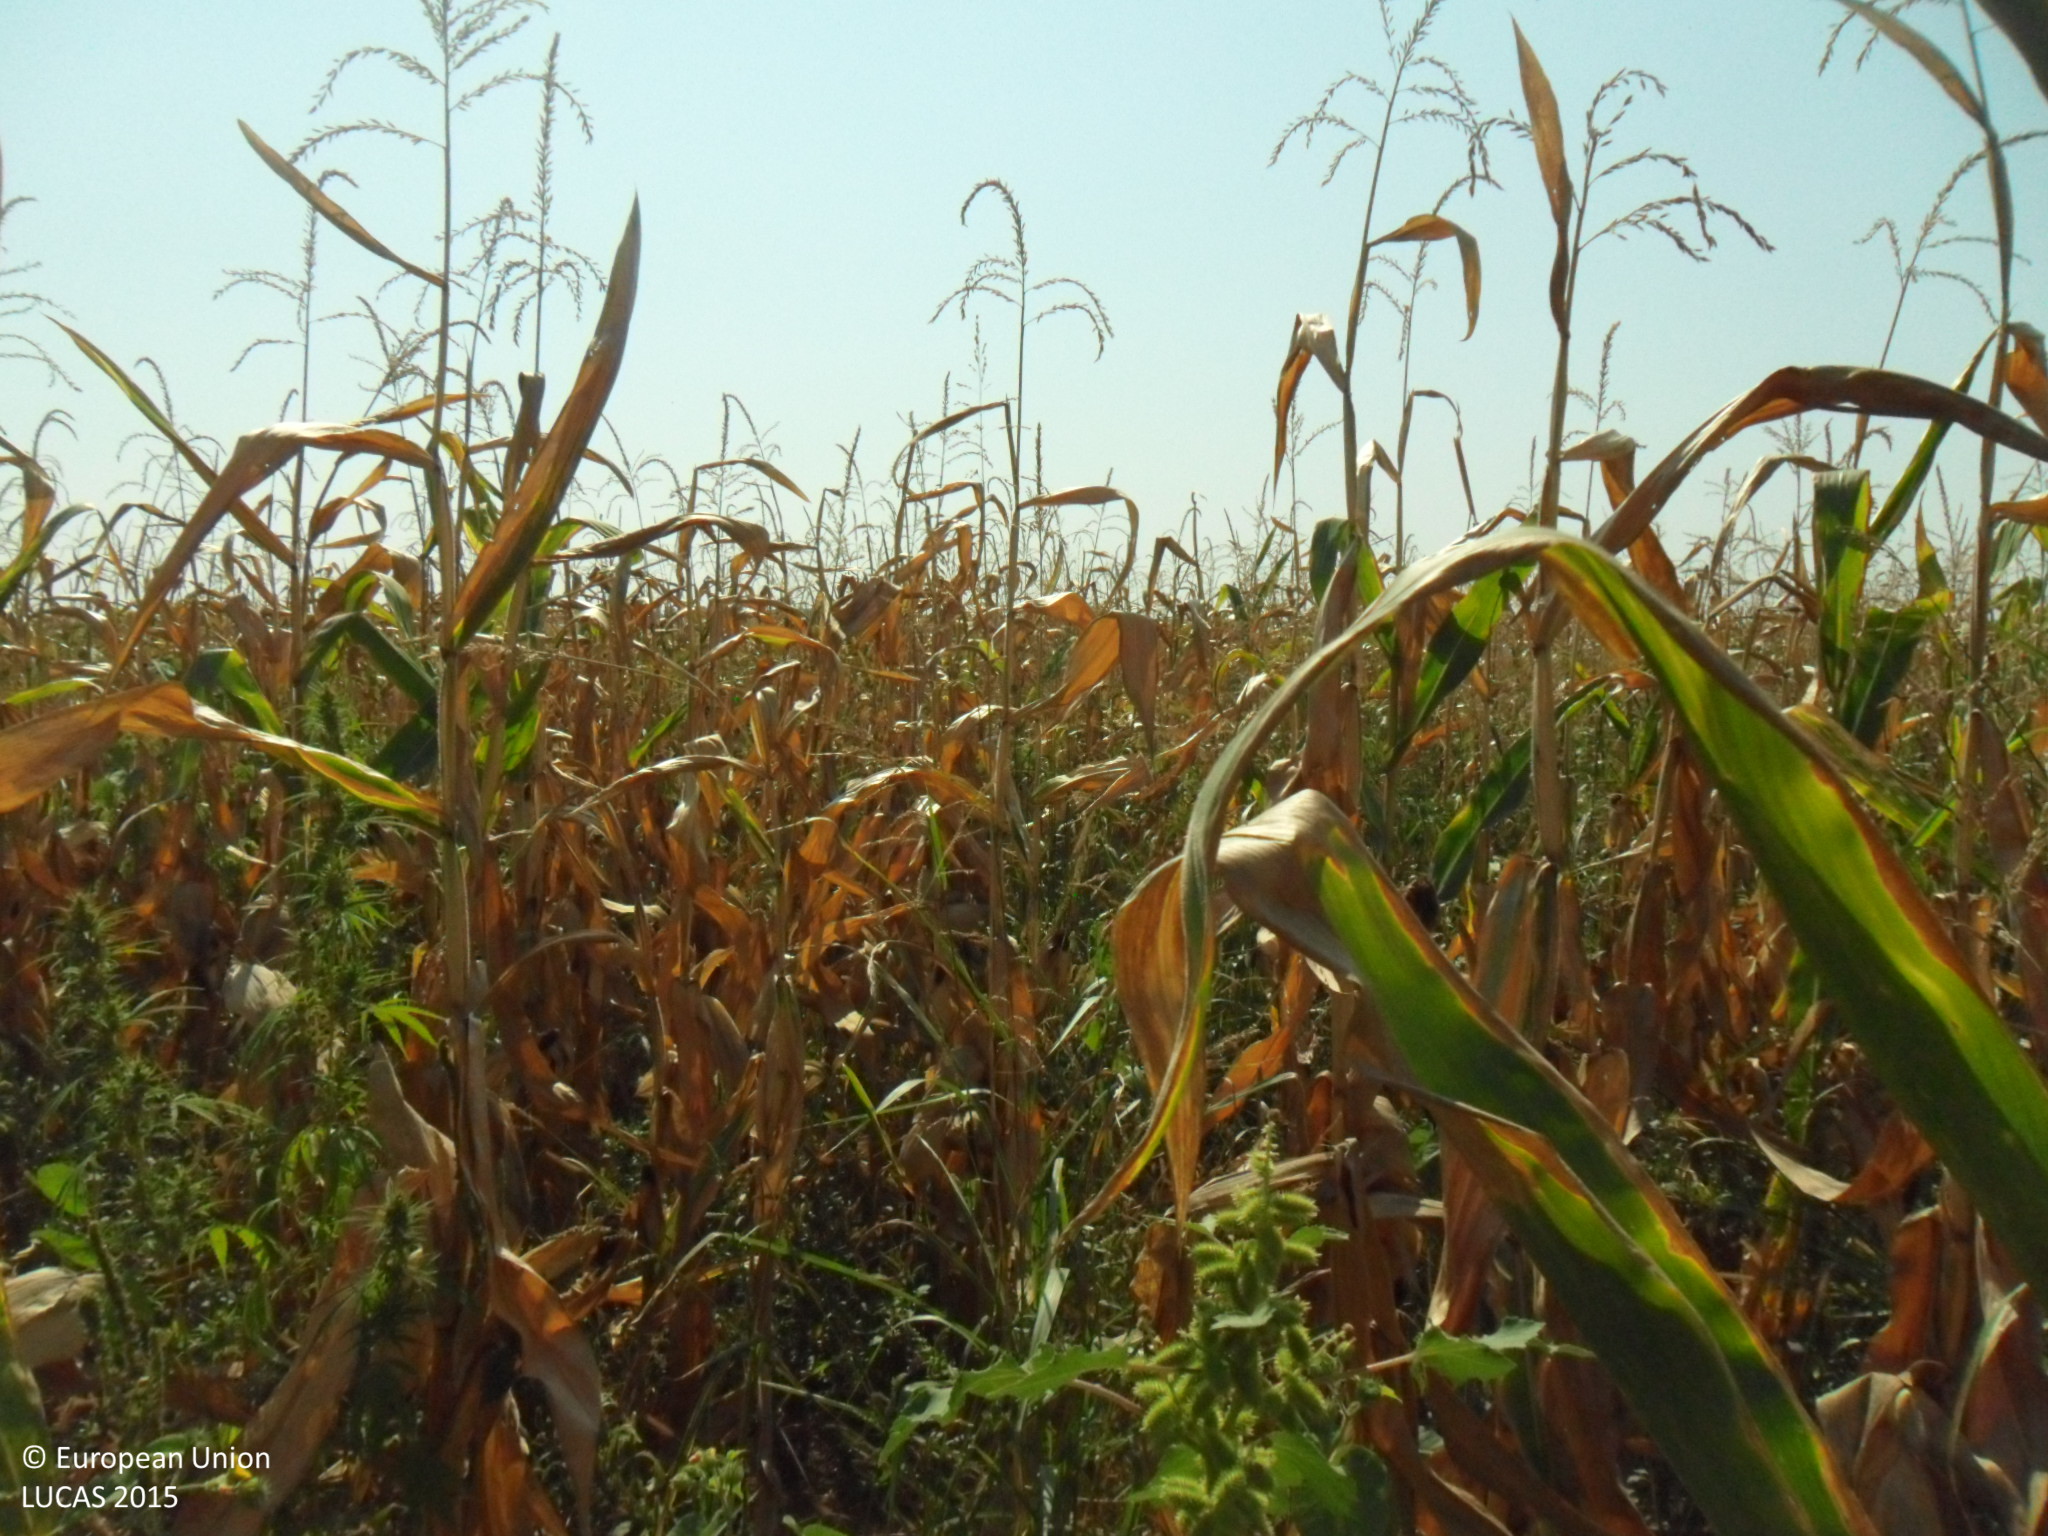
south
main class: Cropland
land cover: Maize
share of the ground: > 75 %
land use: Agriculture (excluding fallow land and kitchen gardens)
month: September
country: BG
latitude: 43.6792
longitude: 26.6197
